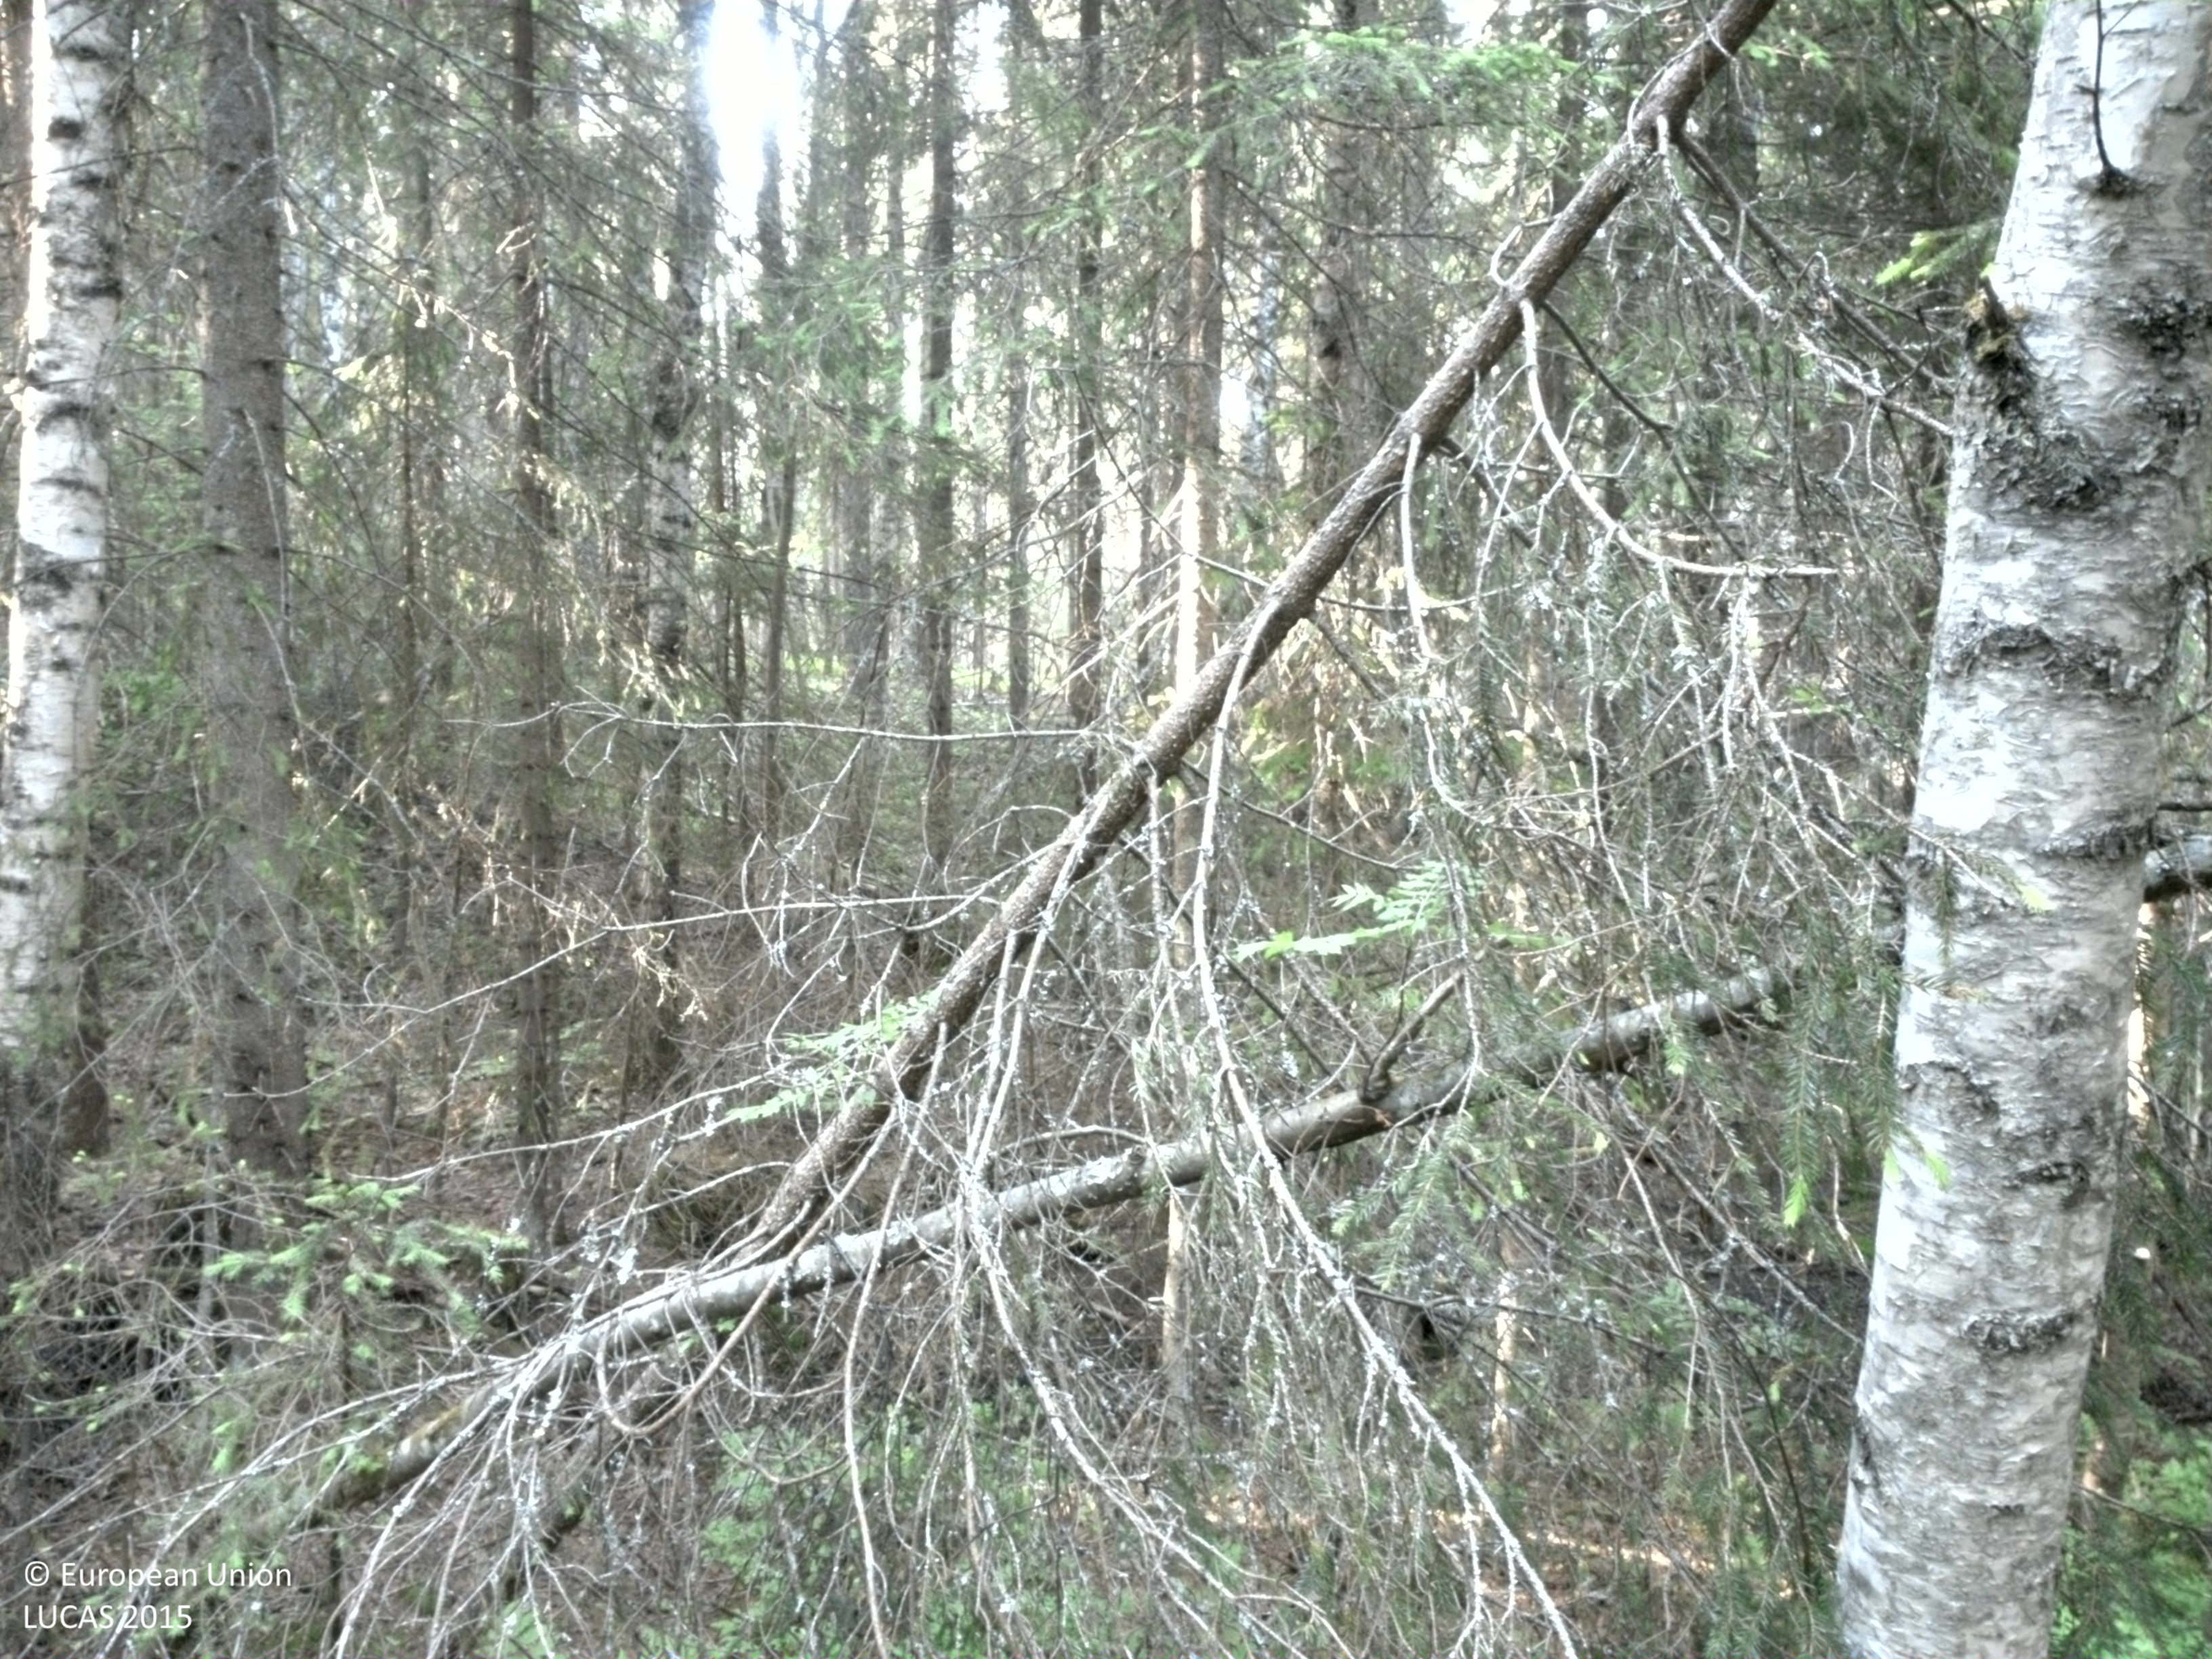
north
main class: Woodland
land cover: Spruce dominated mixed woodland
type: boreal forest
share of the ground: 50 - 75 %
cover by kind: coniferous forest trees 50 %, broadleaved forest trees 25 %, shrubs 25 %
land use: Forestry
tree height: > 5 m
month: July
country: SE
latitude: 64.3060
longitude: 20.7510
